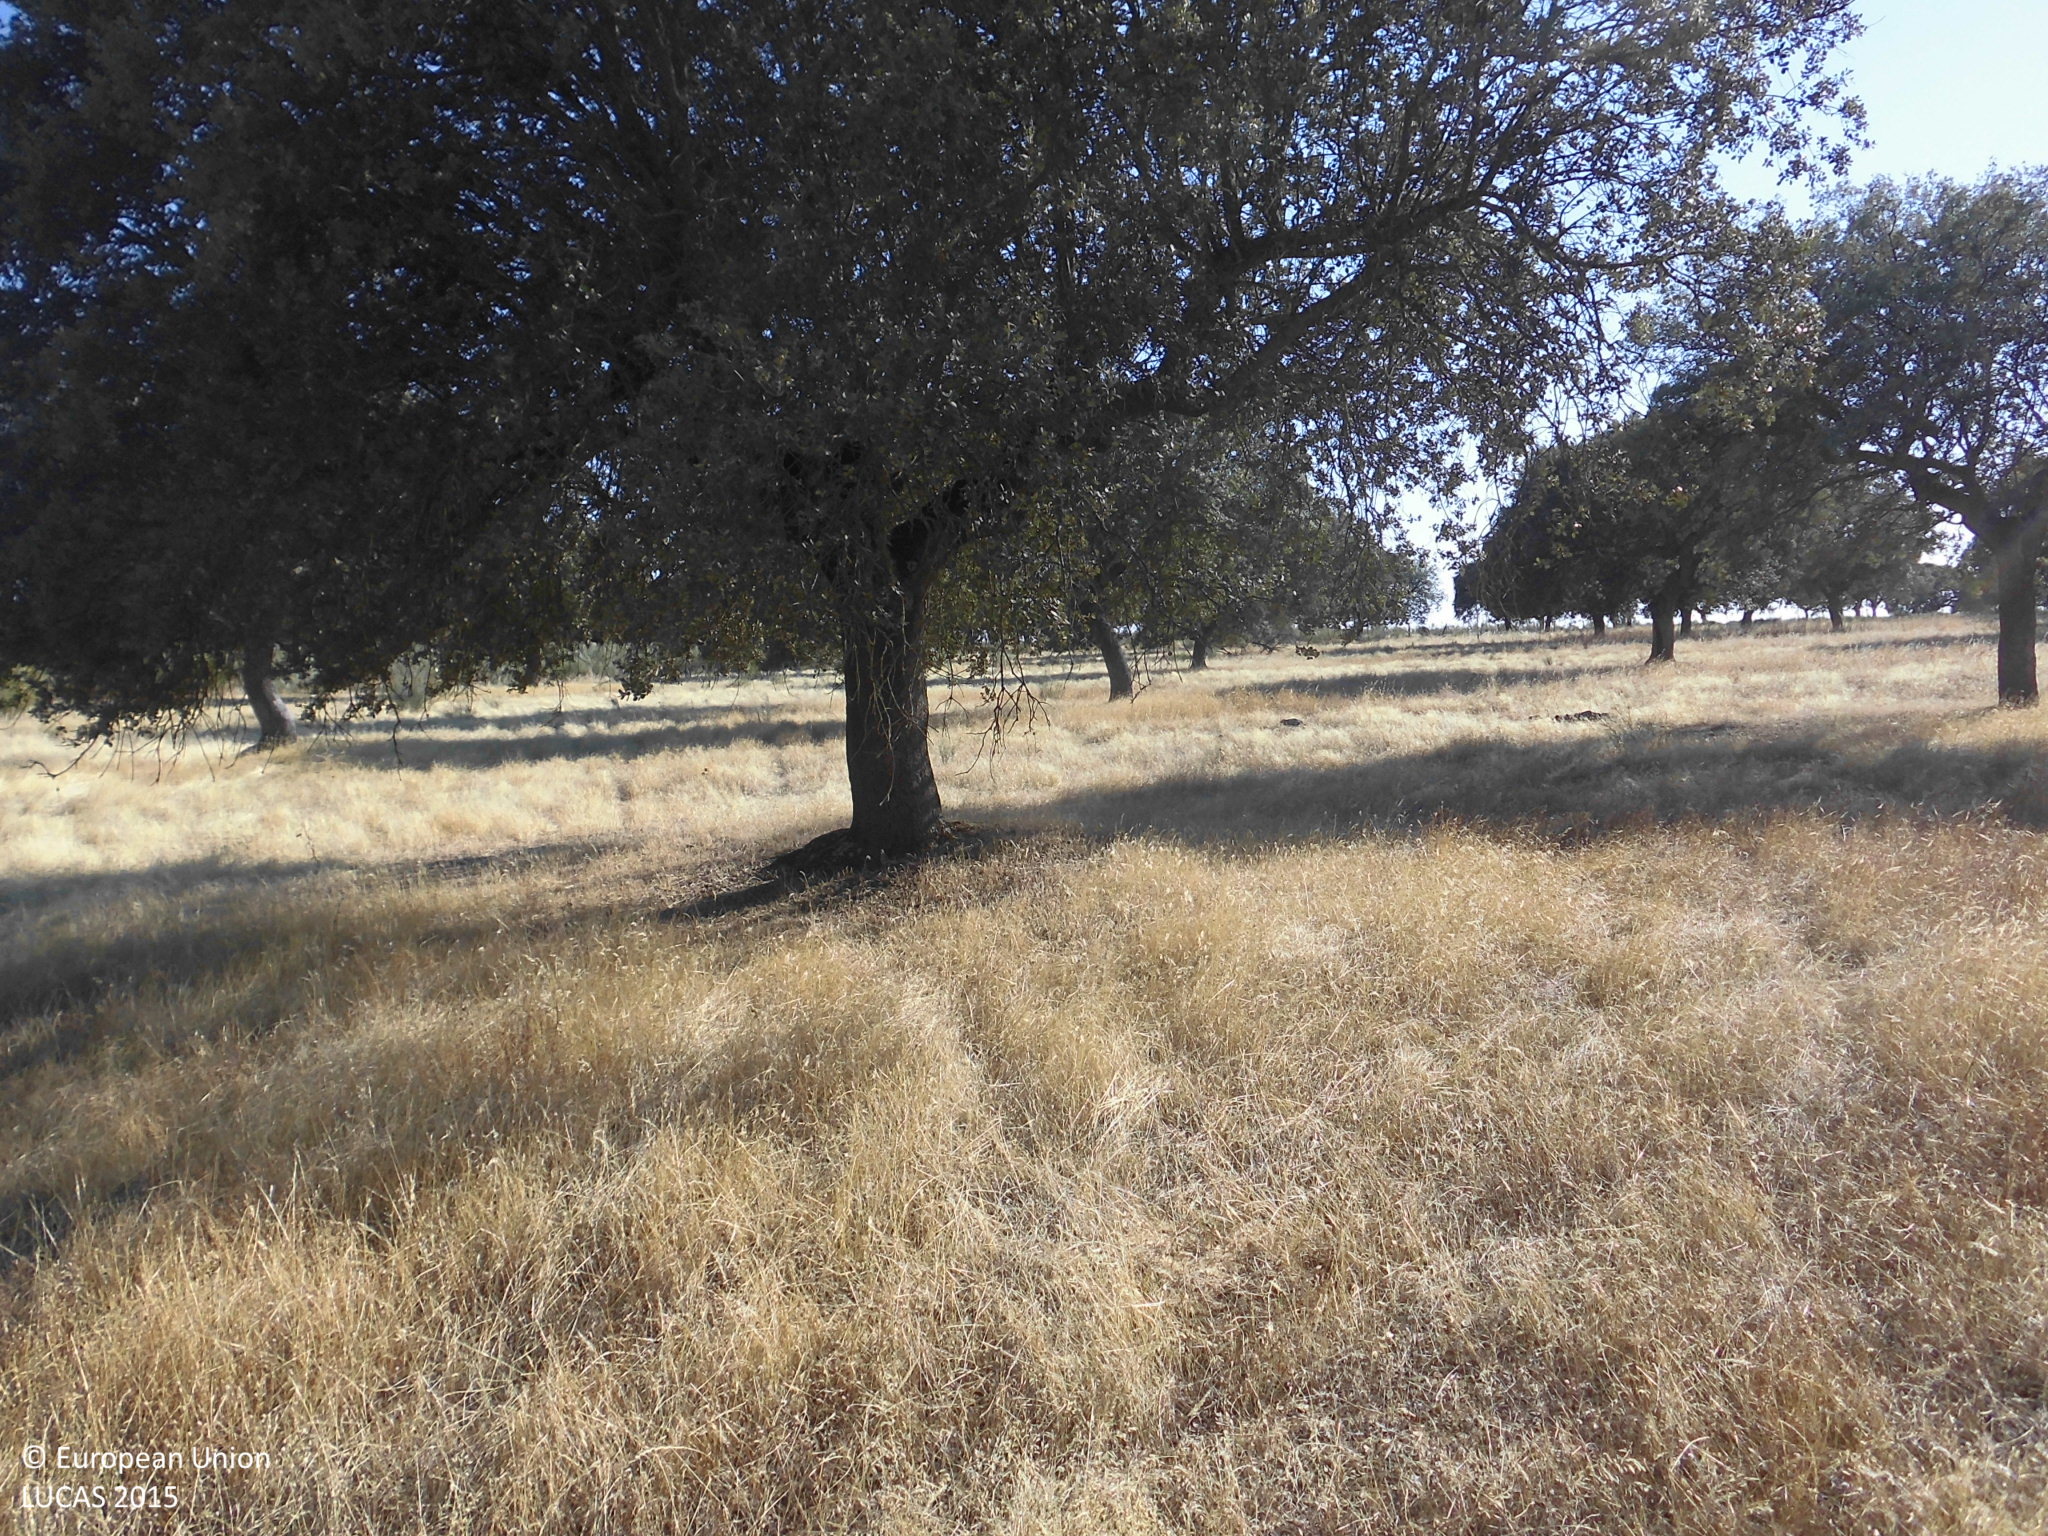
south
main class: Woodland
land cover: Broadleaved woodland
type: broadleaved evergreen forest
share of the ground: 25 - 50 %
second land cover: Grassland without tree/shrub cover
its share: > 75 %
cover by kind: herbaceous plants 65 %, broadleaved forest trees 35 %
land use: Forestry
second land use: Agriculture (excluding fallow land and kitchen gardens)
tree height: > 5 m
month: July
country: ES
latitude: 39.5562
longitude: -5.6390
